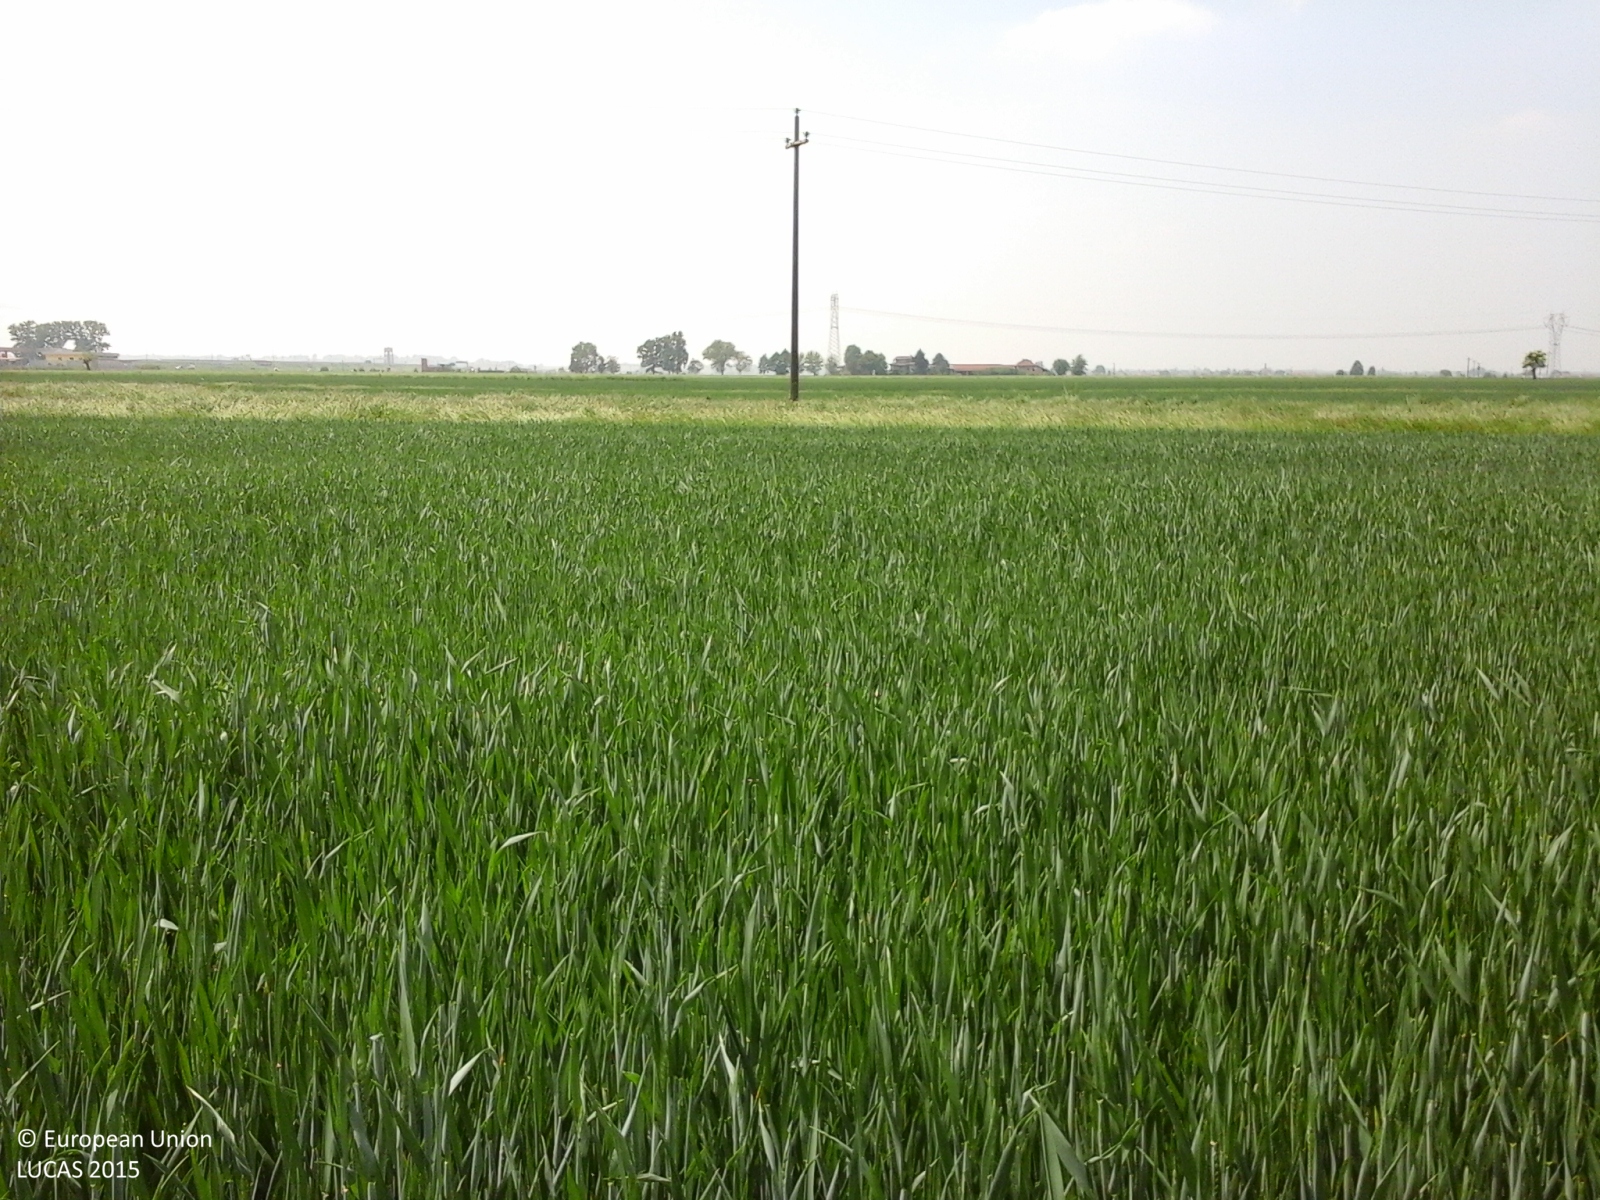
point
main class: Cropland
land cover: Common wheat
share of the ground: > 75 %
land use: Agriculture (excluding fallow land and kitchen gardens)
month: May
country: IT
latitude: 44.6705
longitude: 7.8221
